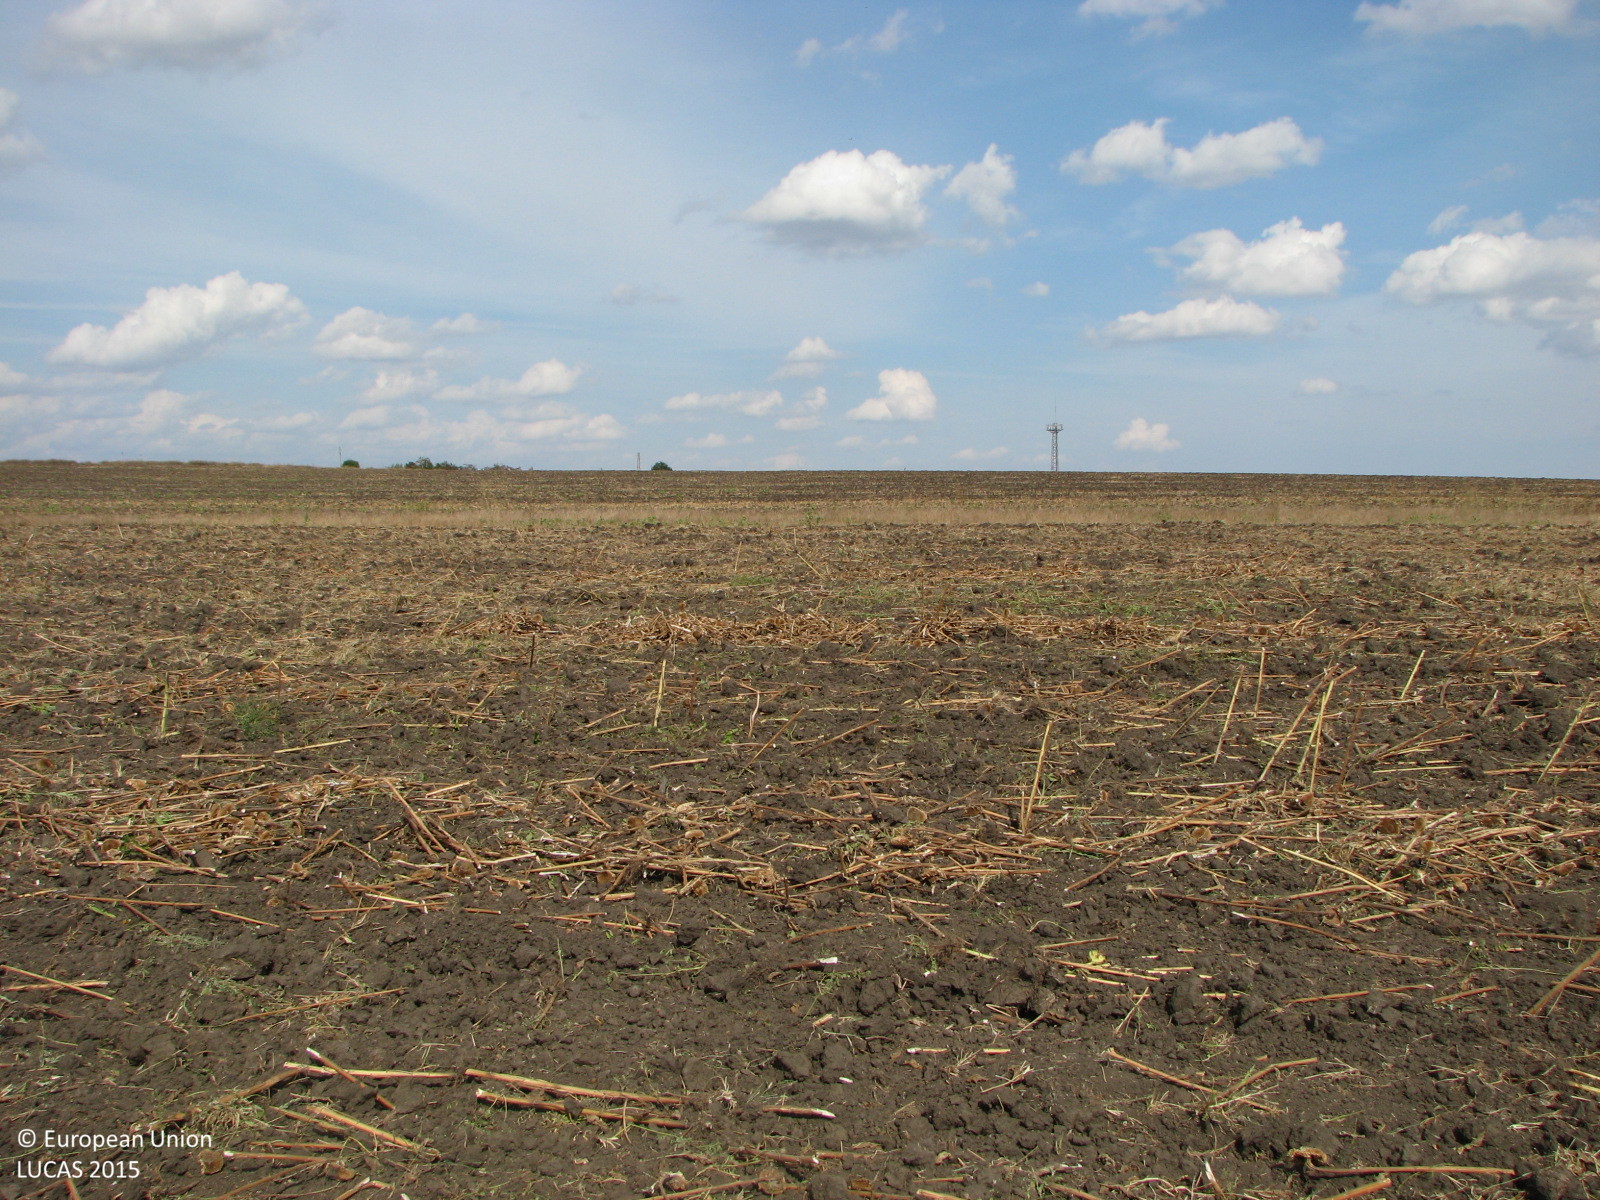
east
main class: Cropland
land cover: Sunflower
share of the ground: < 10 %
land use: Agriculture (excluding fallow land and kitchen gardens)
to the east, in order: Sunflower; Grass margins; Tracks; Grass margins; Other bare soil
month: September
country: BG
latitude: 42.4938
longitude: 26.7804
